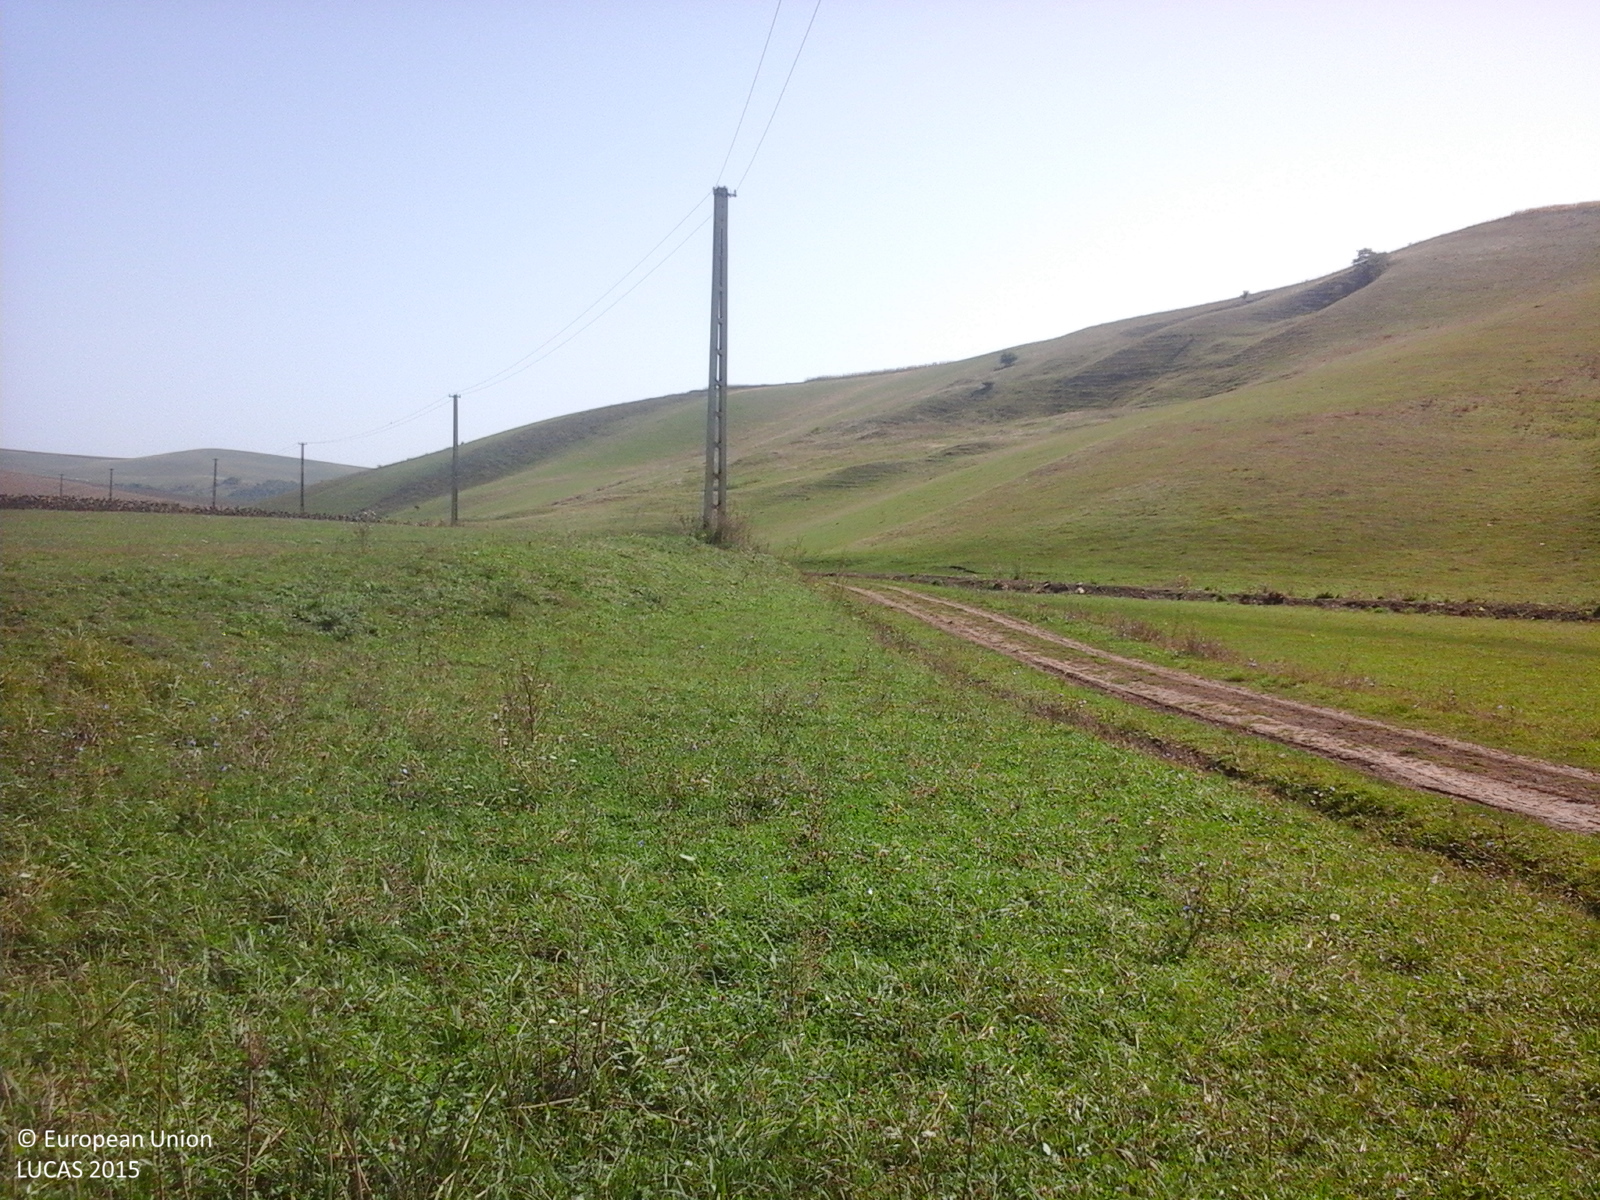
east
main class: Grassland
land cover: Grassland without tree/shrub cover
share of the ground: > 75 %
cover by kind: herbaceous plants 100 %
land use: Agriculture (excluding fallow land and kitchen gardens)
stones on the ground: < 10 %
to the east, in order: Grassland without tree/shrub cover; Electric lines; Grass margins; Tracks; Grassland without tree/shrub cover; Rivers and streams; Grassland without tree/shrub cover
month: September
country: RO
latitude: 46.7176
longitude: 24.1715
